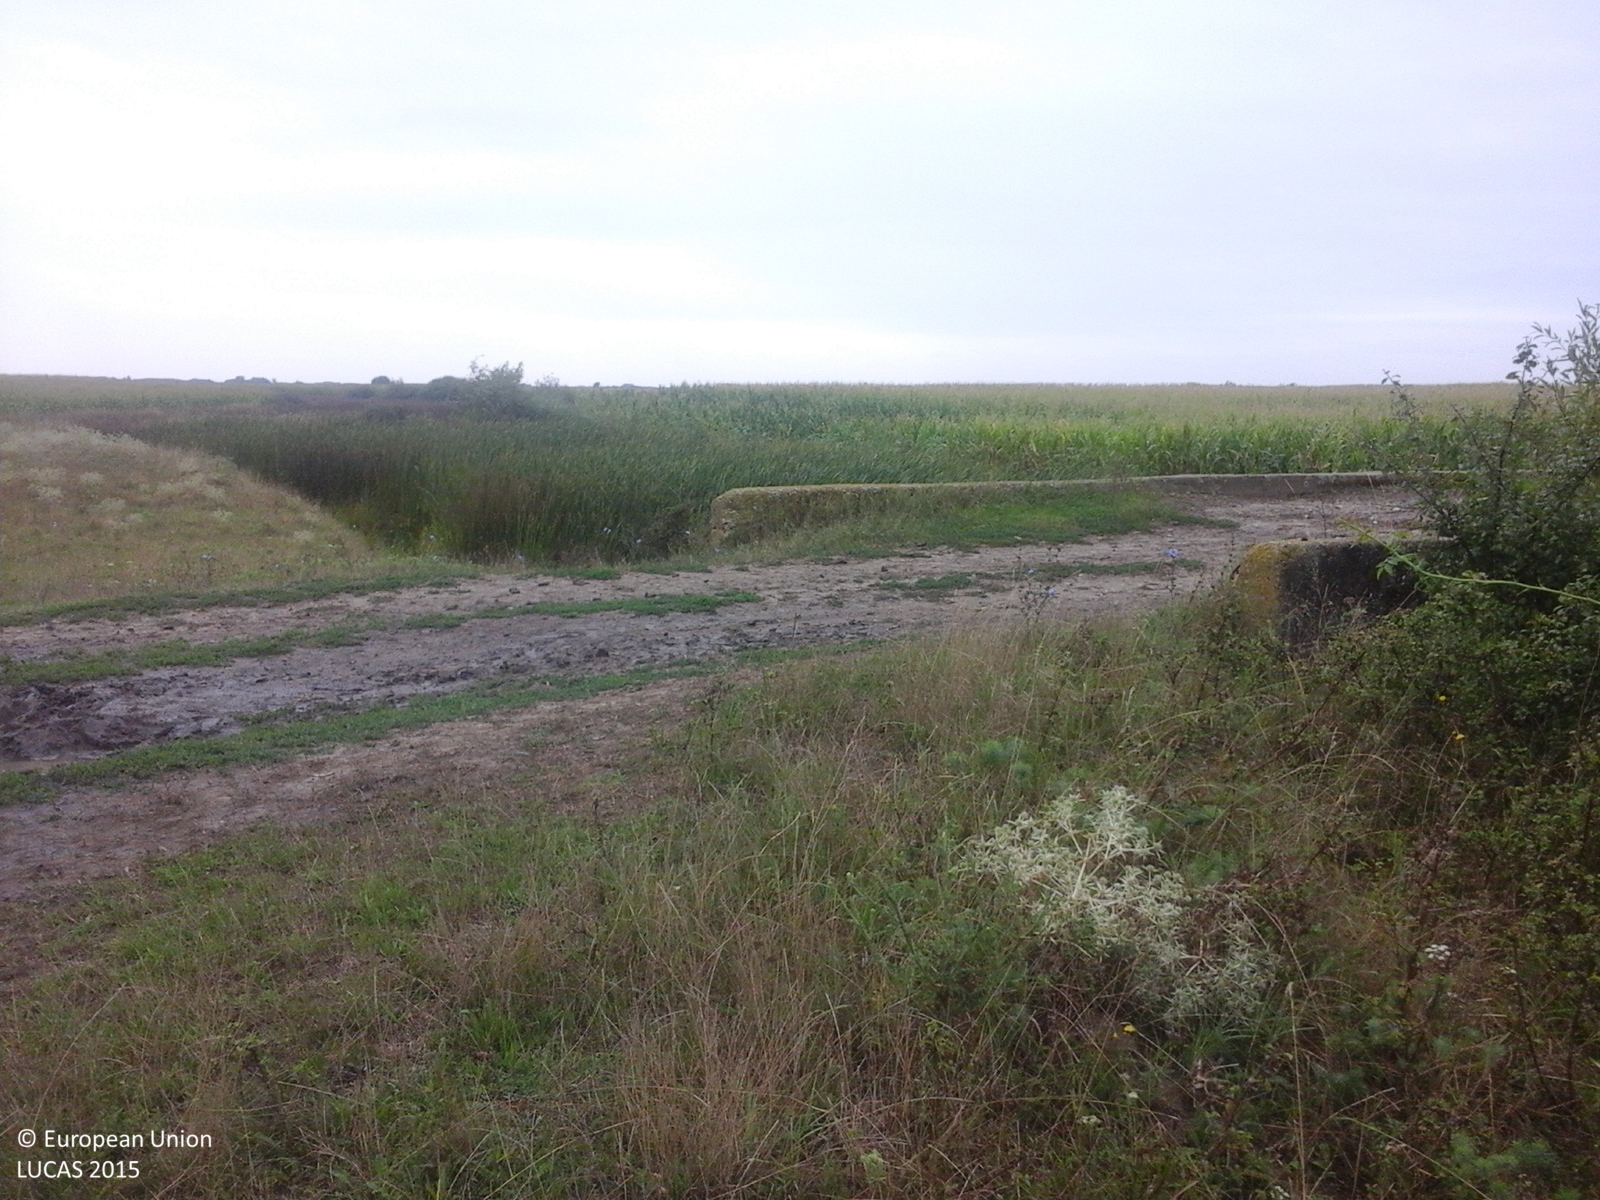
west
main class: Grassland
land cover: Grassland without tree/shrub cover
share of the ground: > 75 %
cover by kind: herbaceous plants 100 %
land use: Agriculture (excluding fallow land and kitchen gardens)
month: August
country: RO
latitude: 45.4057
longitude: 20.9493
